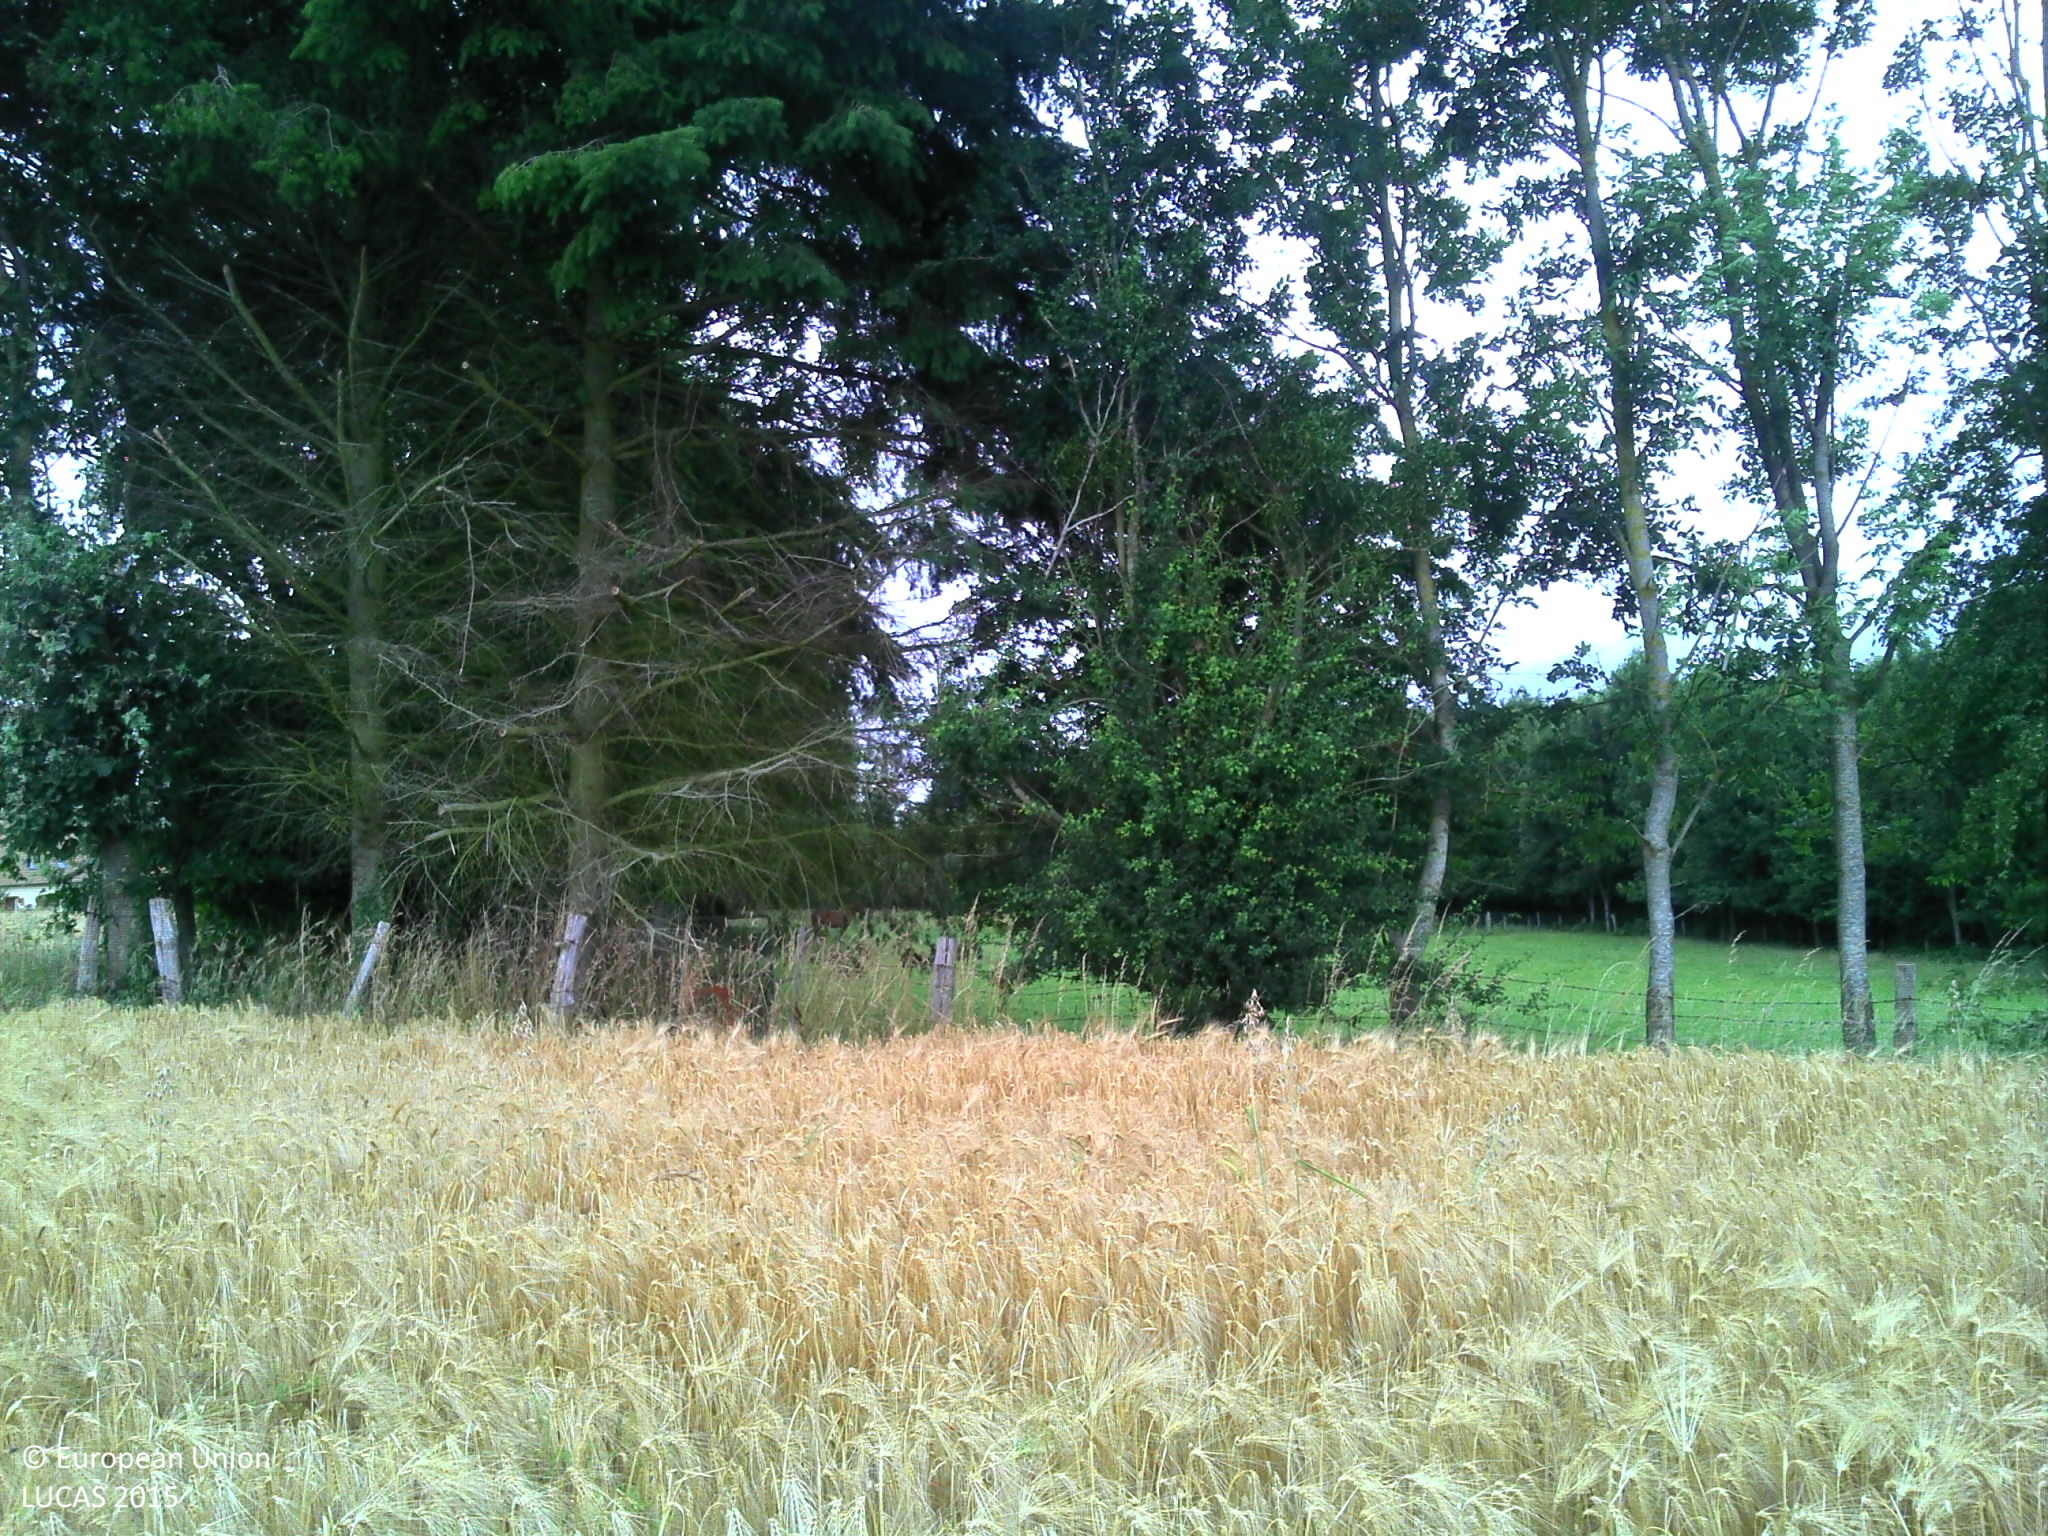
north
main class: Cropland
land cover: Barley
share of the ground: > 75 %
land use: Agriculture (excluding fallow land and kitchen gardens)
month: July
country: FR
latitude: 49.3287
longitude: 0.4374
